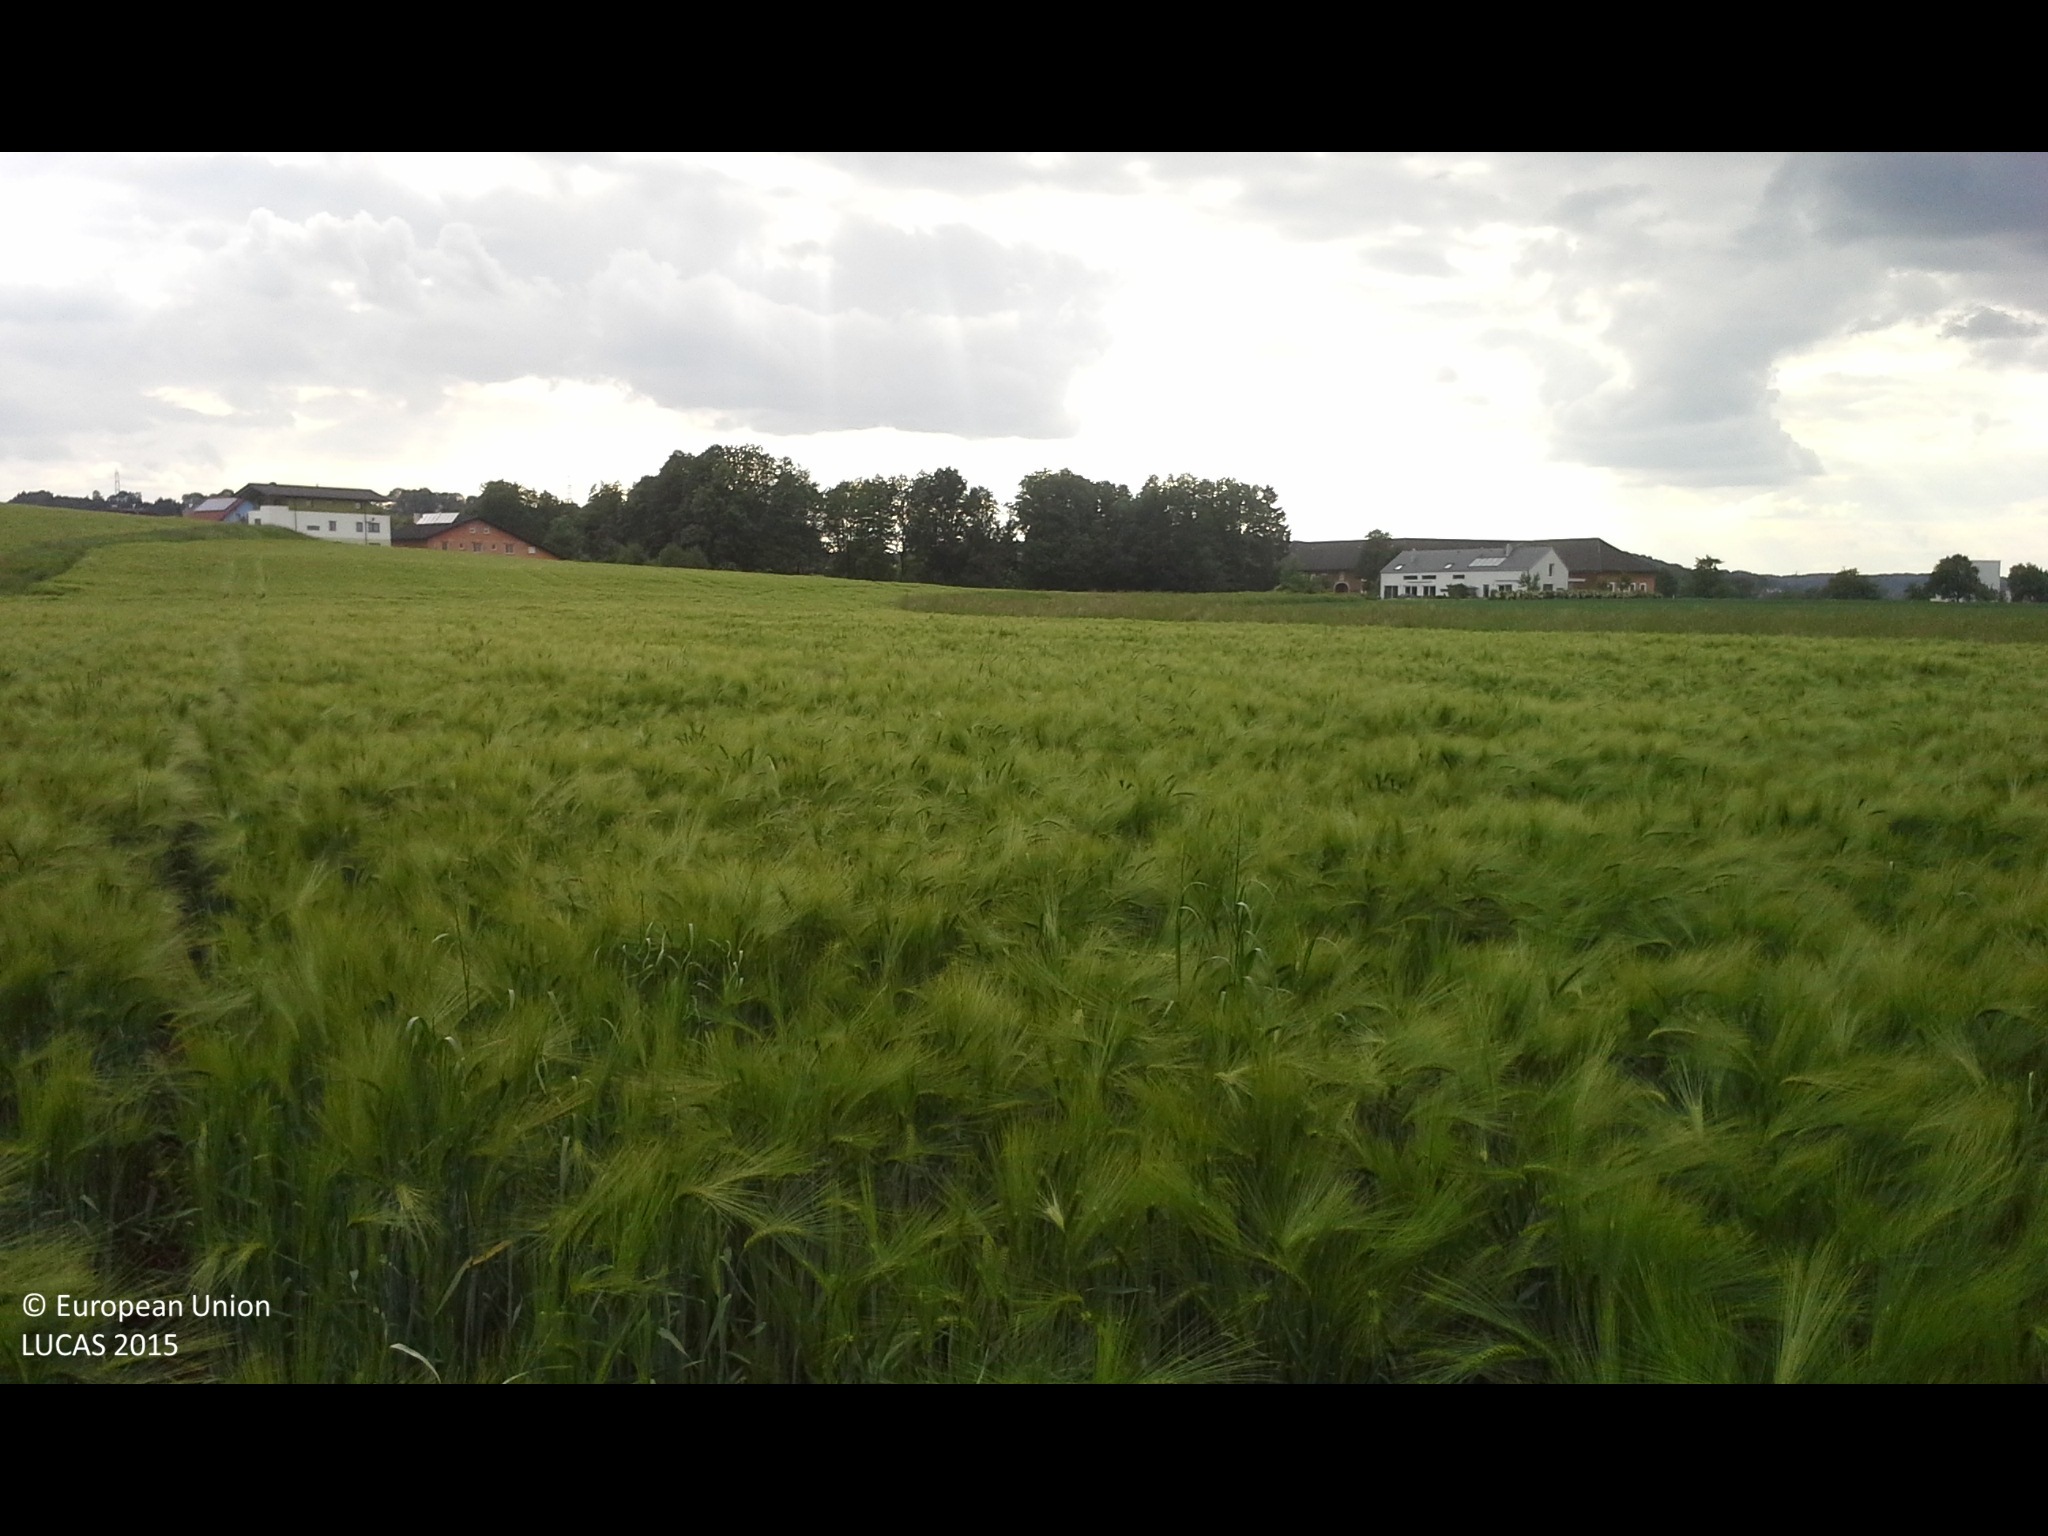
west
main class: Cropland
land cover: Barley
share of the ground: > 75 %
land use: Agriculture (excluding fallow land and kitchen gardens)
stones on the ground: < 10 %
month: May
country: AT
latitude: 48.2067
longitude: 14.4273
